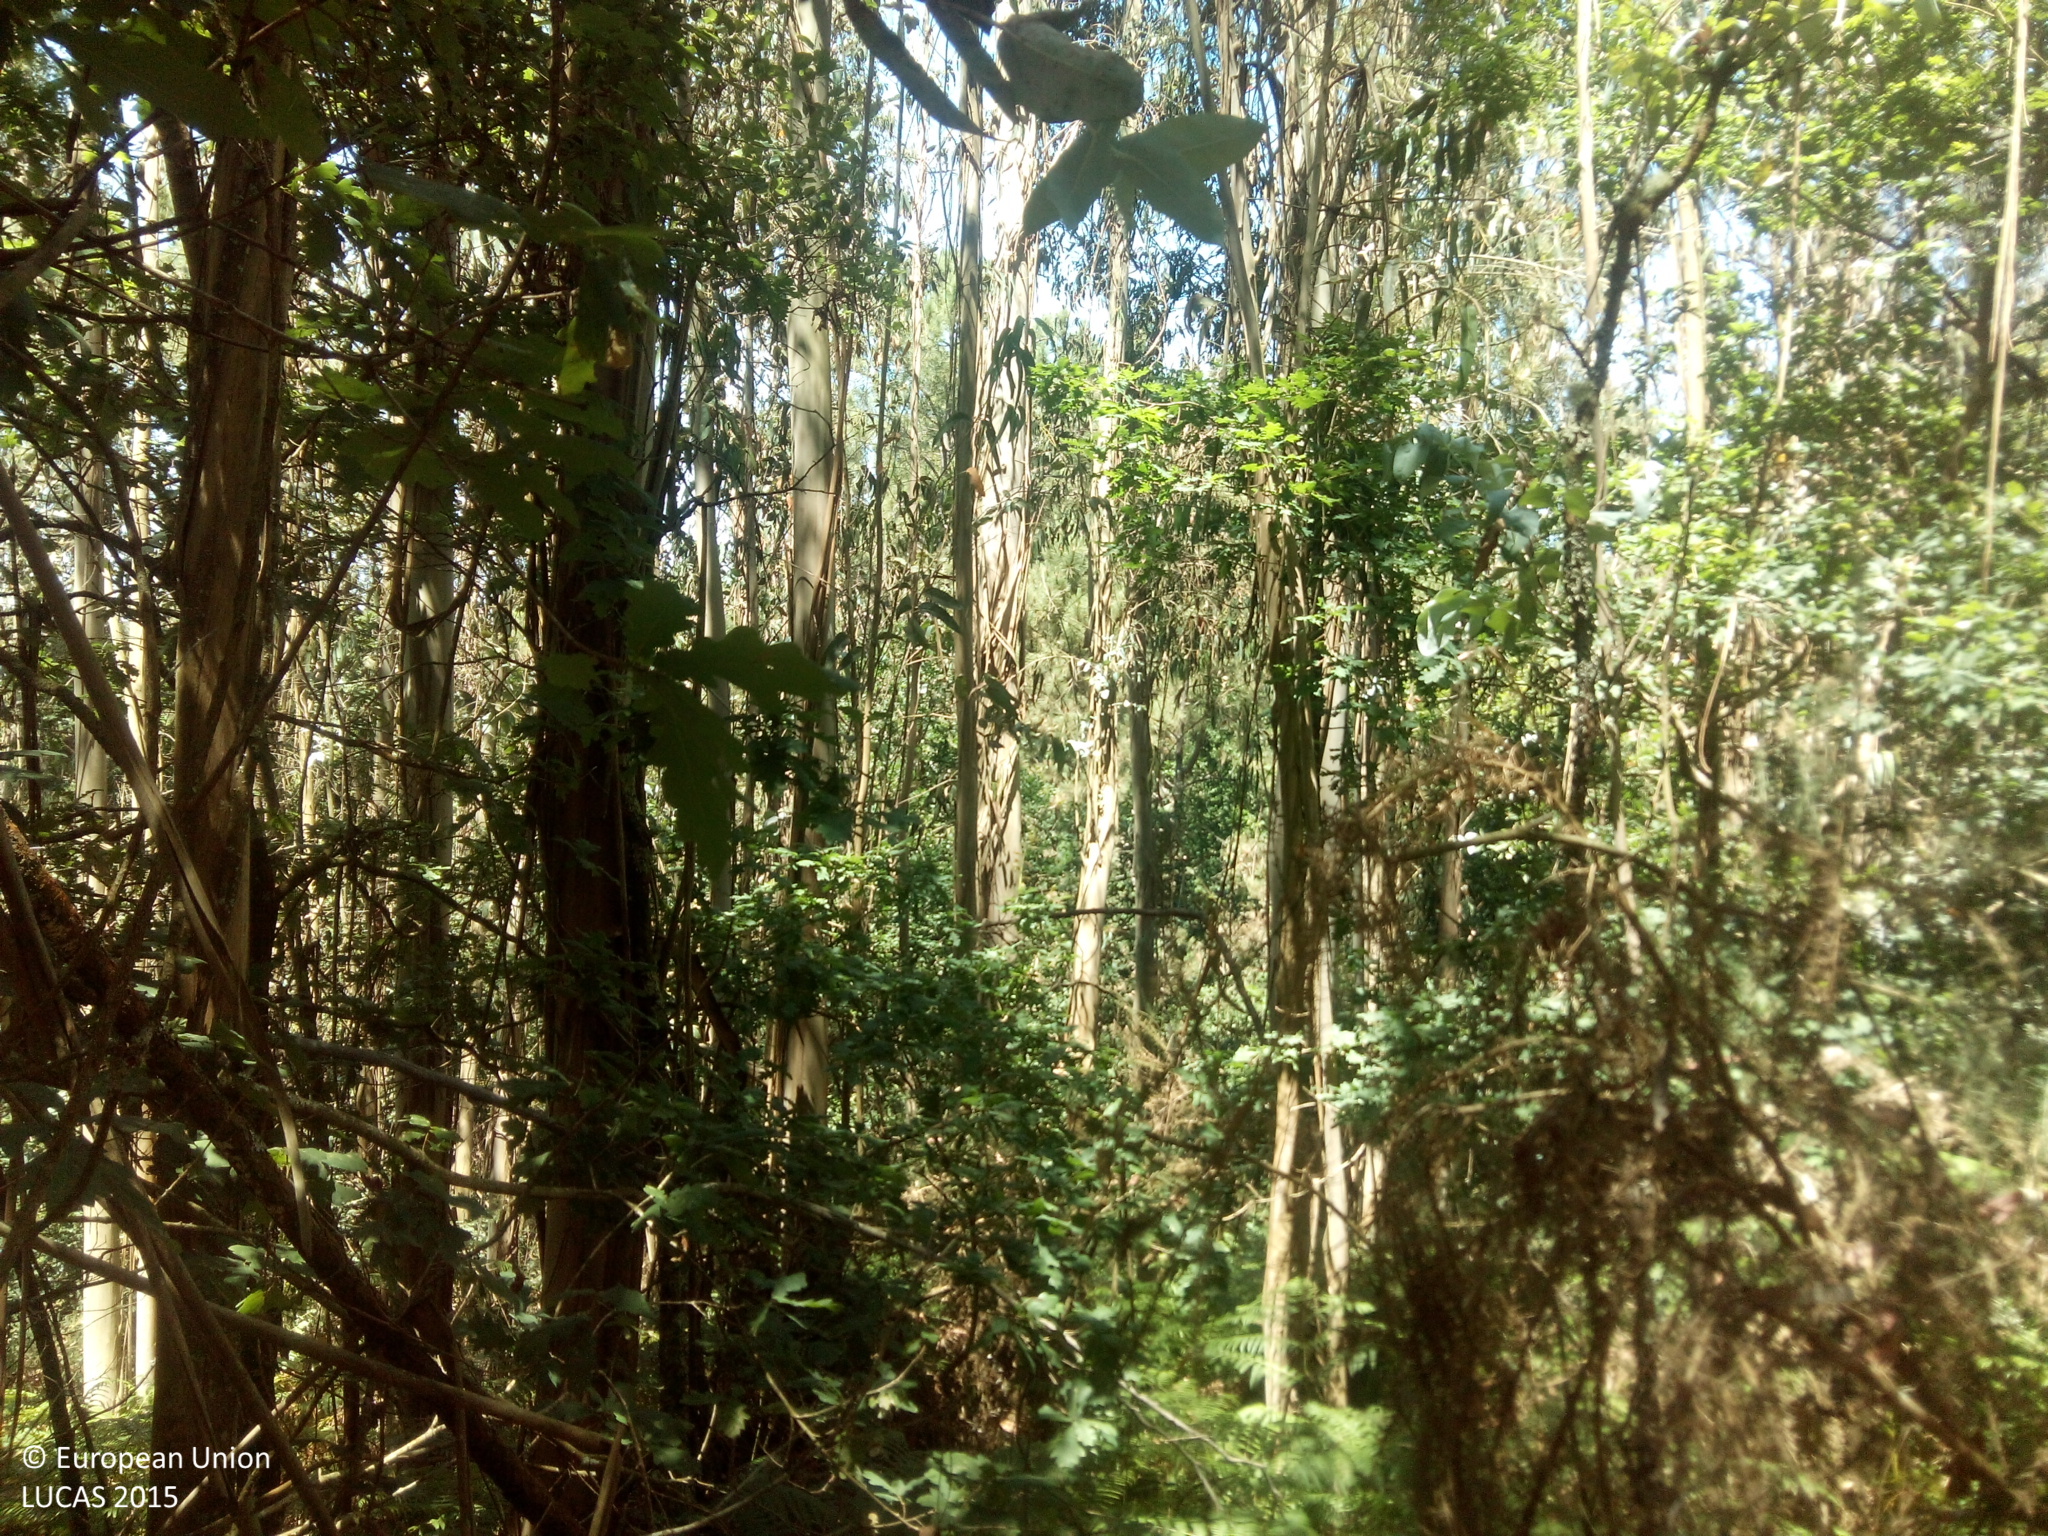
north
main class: Woodland
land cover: Broadleaved woodland
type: exotic forest
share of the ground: > 75 %
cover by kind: broadleaved forest trees 100 %
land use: Forestry
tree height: > 5 m
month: June
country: ES
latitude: 42.7455
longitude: -8.3861
